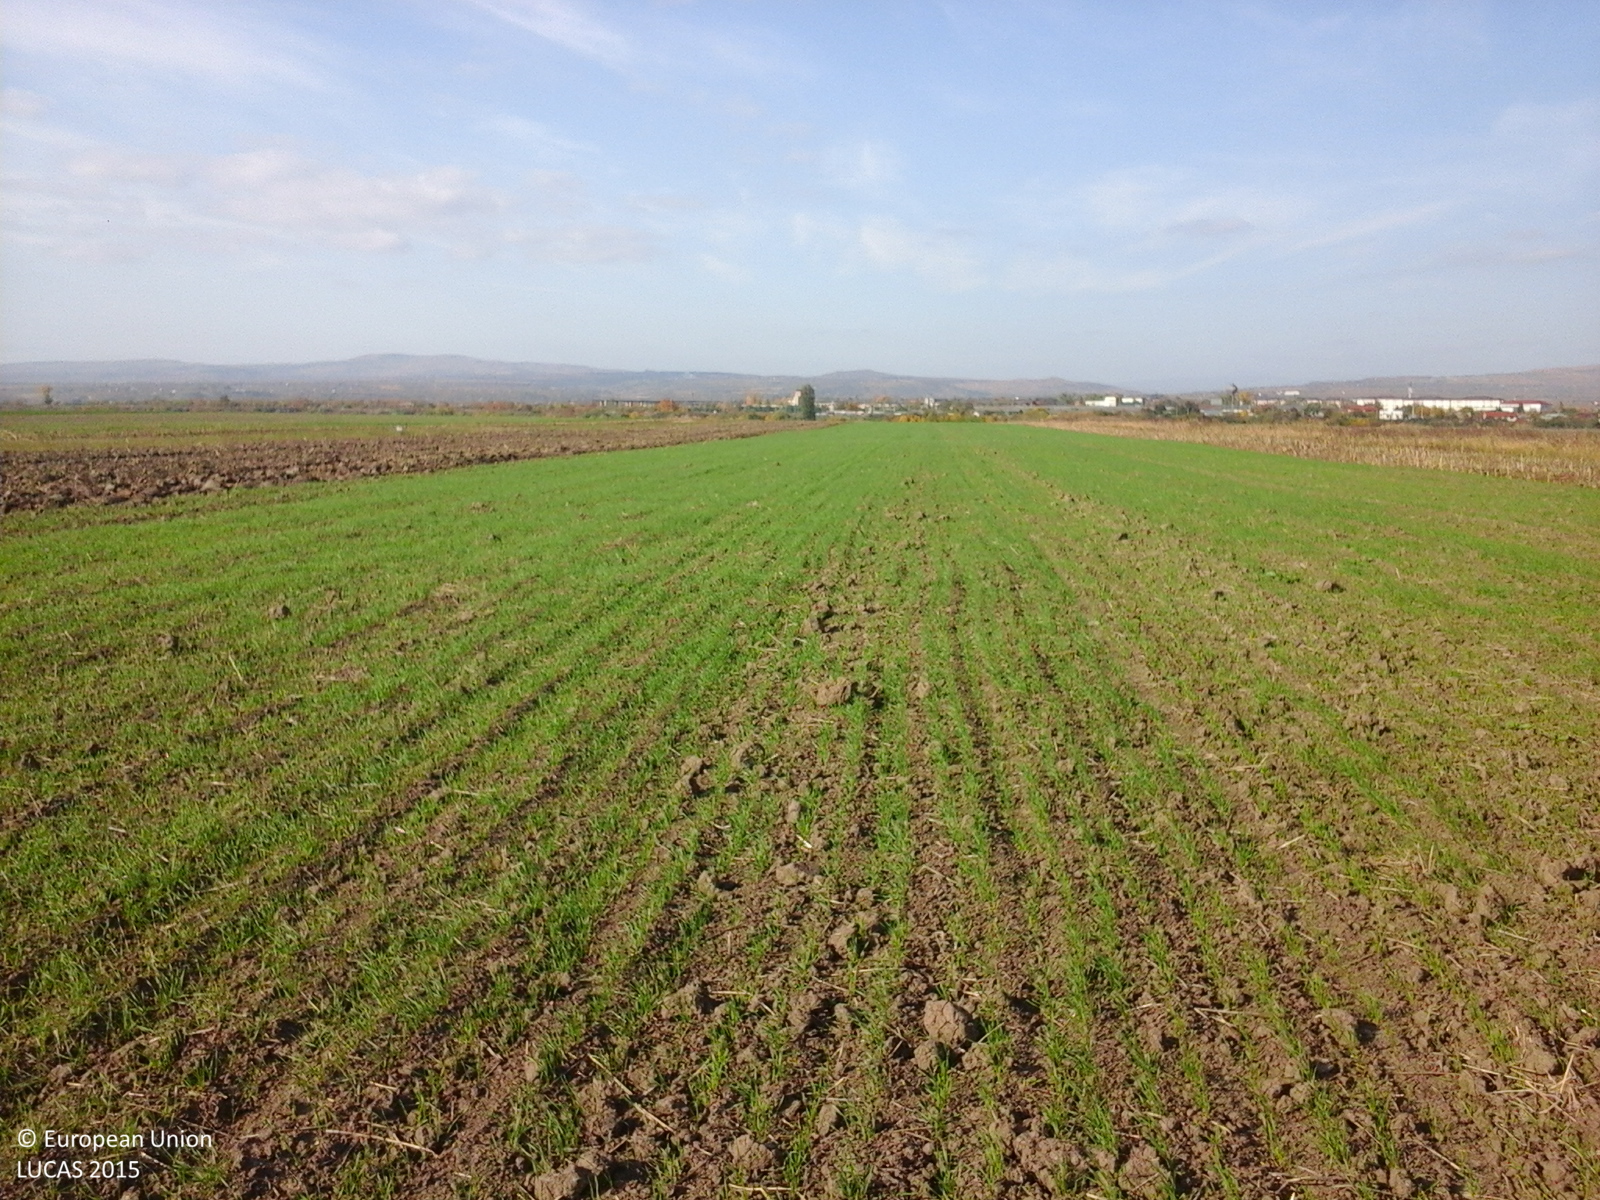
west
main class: Cropland
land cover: Common wheat
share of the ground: 10 - 25 %
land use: Agriculture (excluding fallow land and kitchen gardens)
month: October
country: RO
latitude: 45.5608
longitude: 27.1445
